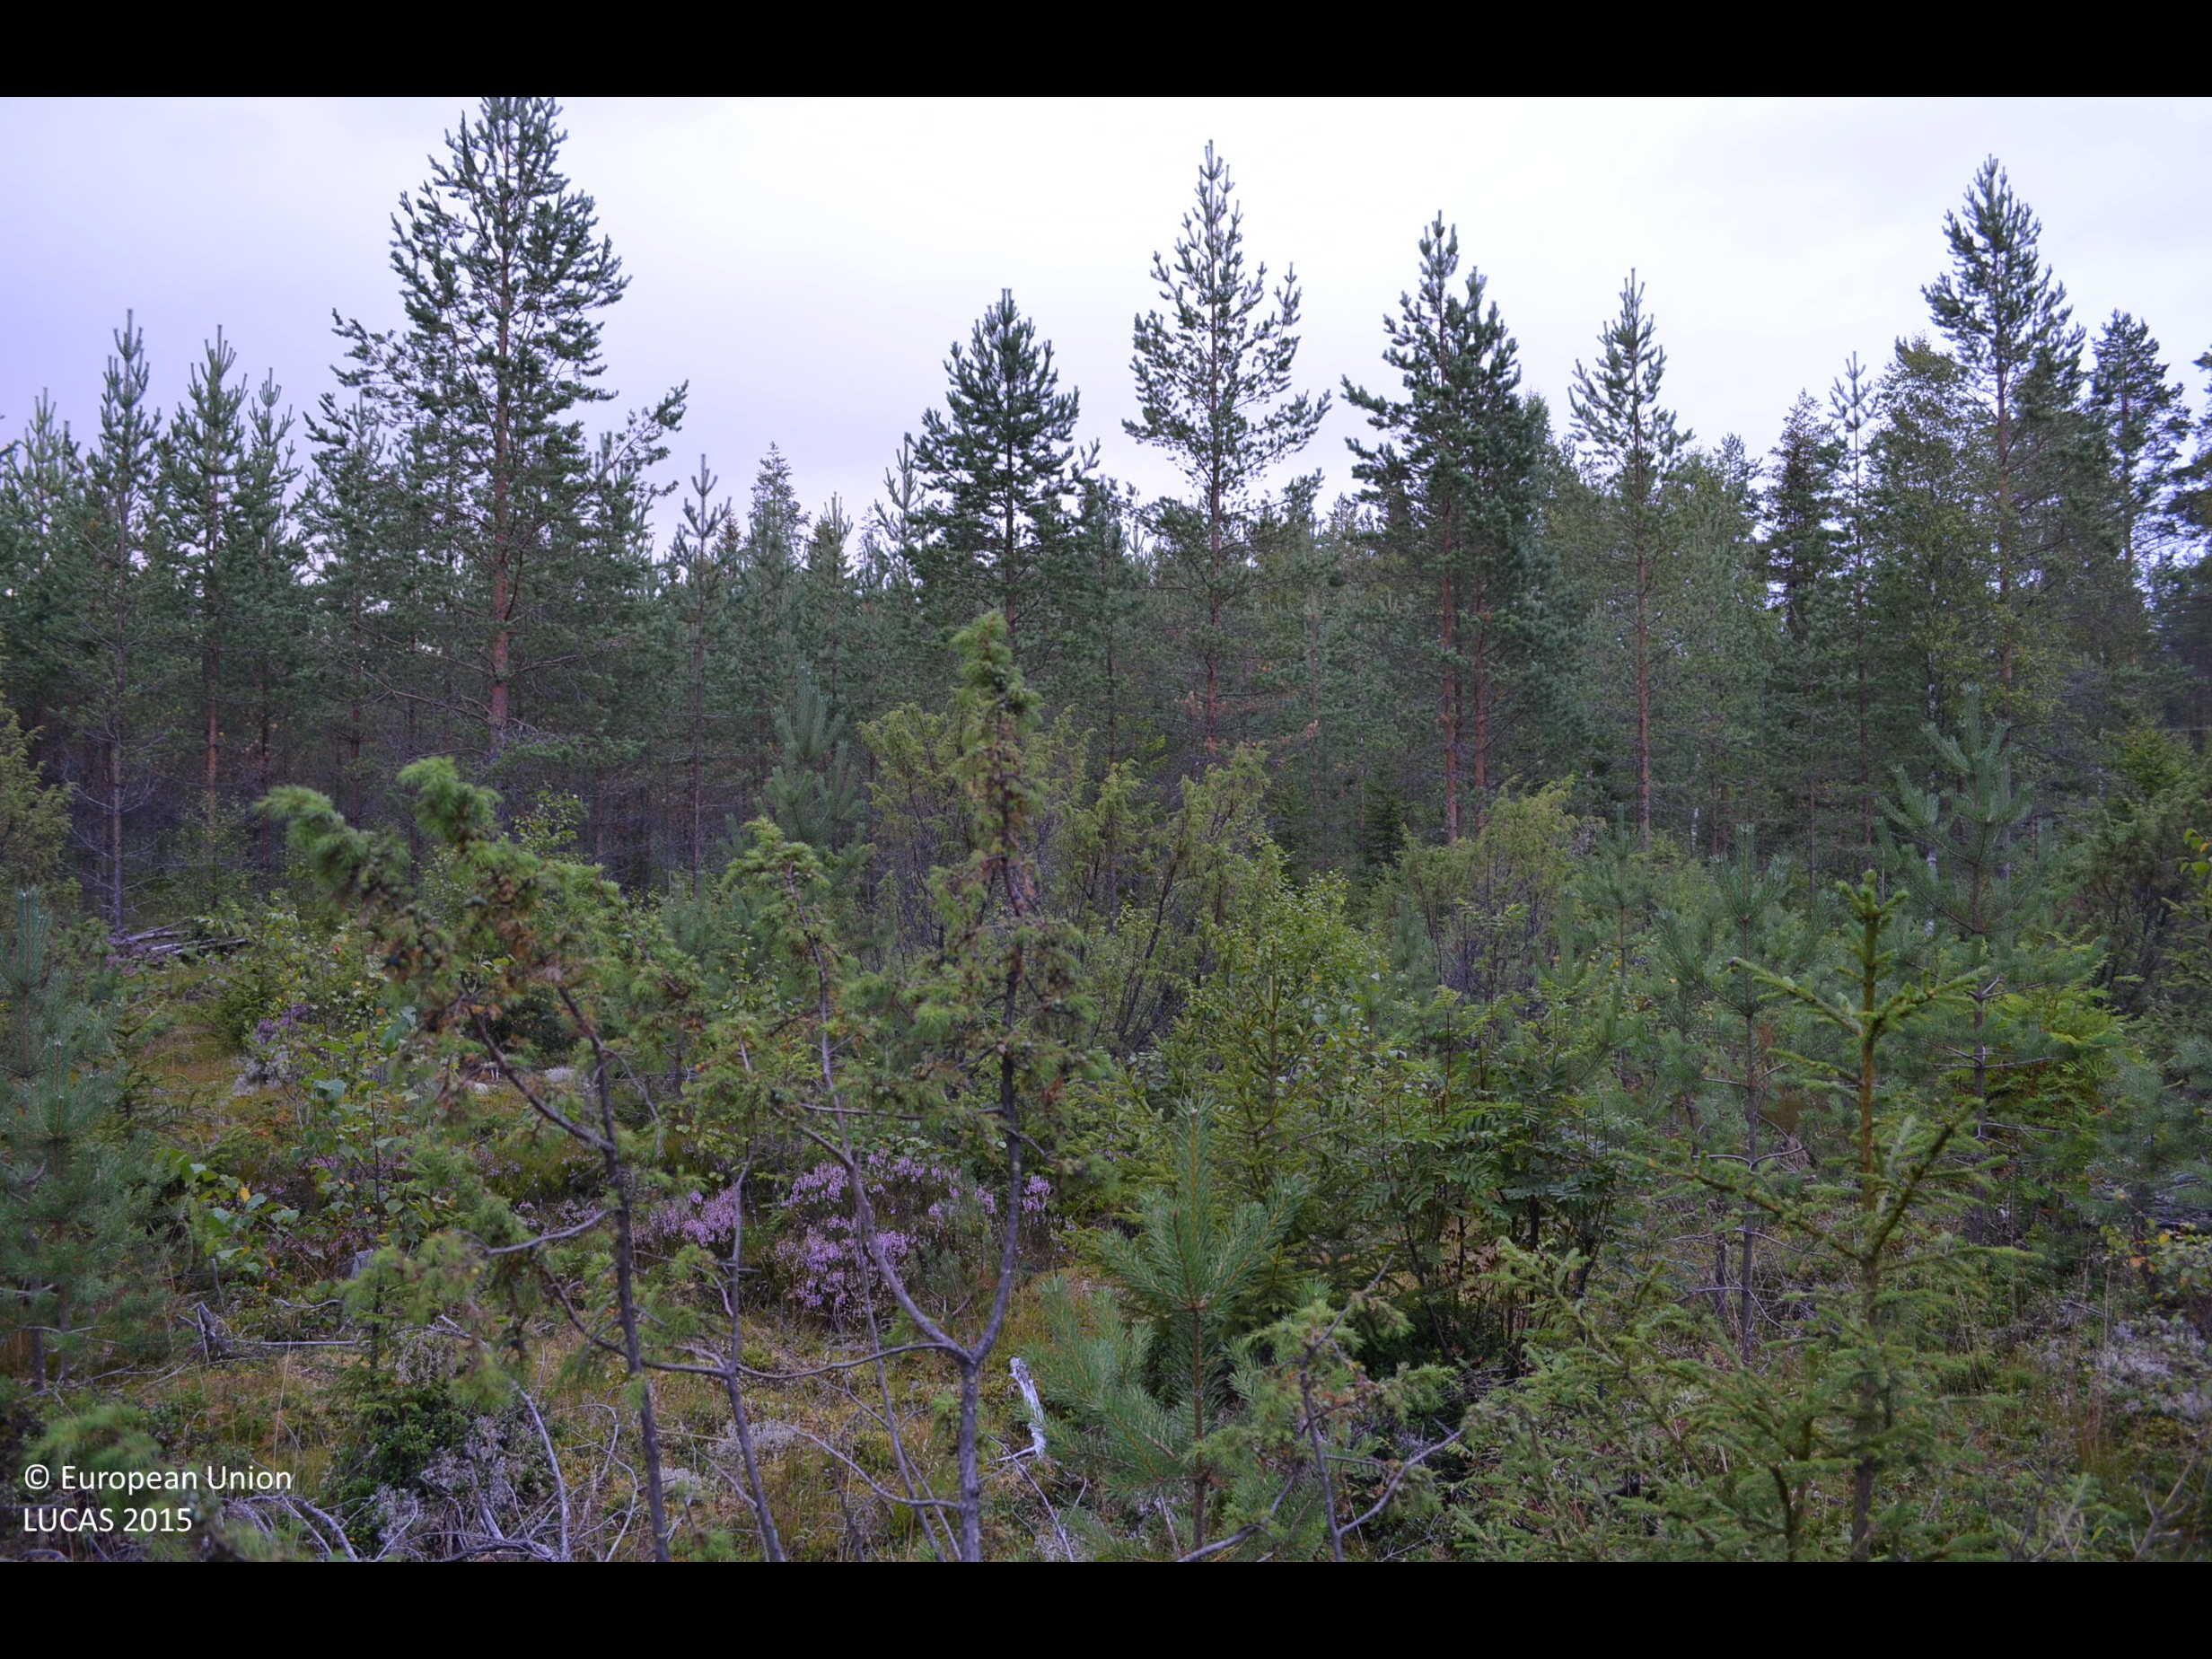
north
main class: Artificial land
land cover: Other artificial areas
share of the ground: < 10 %
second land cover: Other mixed woodland
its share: 25 - 50 %
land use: Electricity, gas and thermal power distribution
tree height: < 5 m
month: August
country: FI
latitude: 62.2753
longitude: 24.2879
